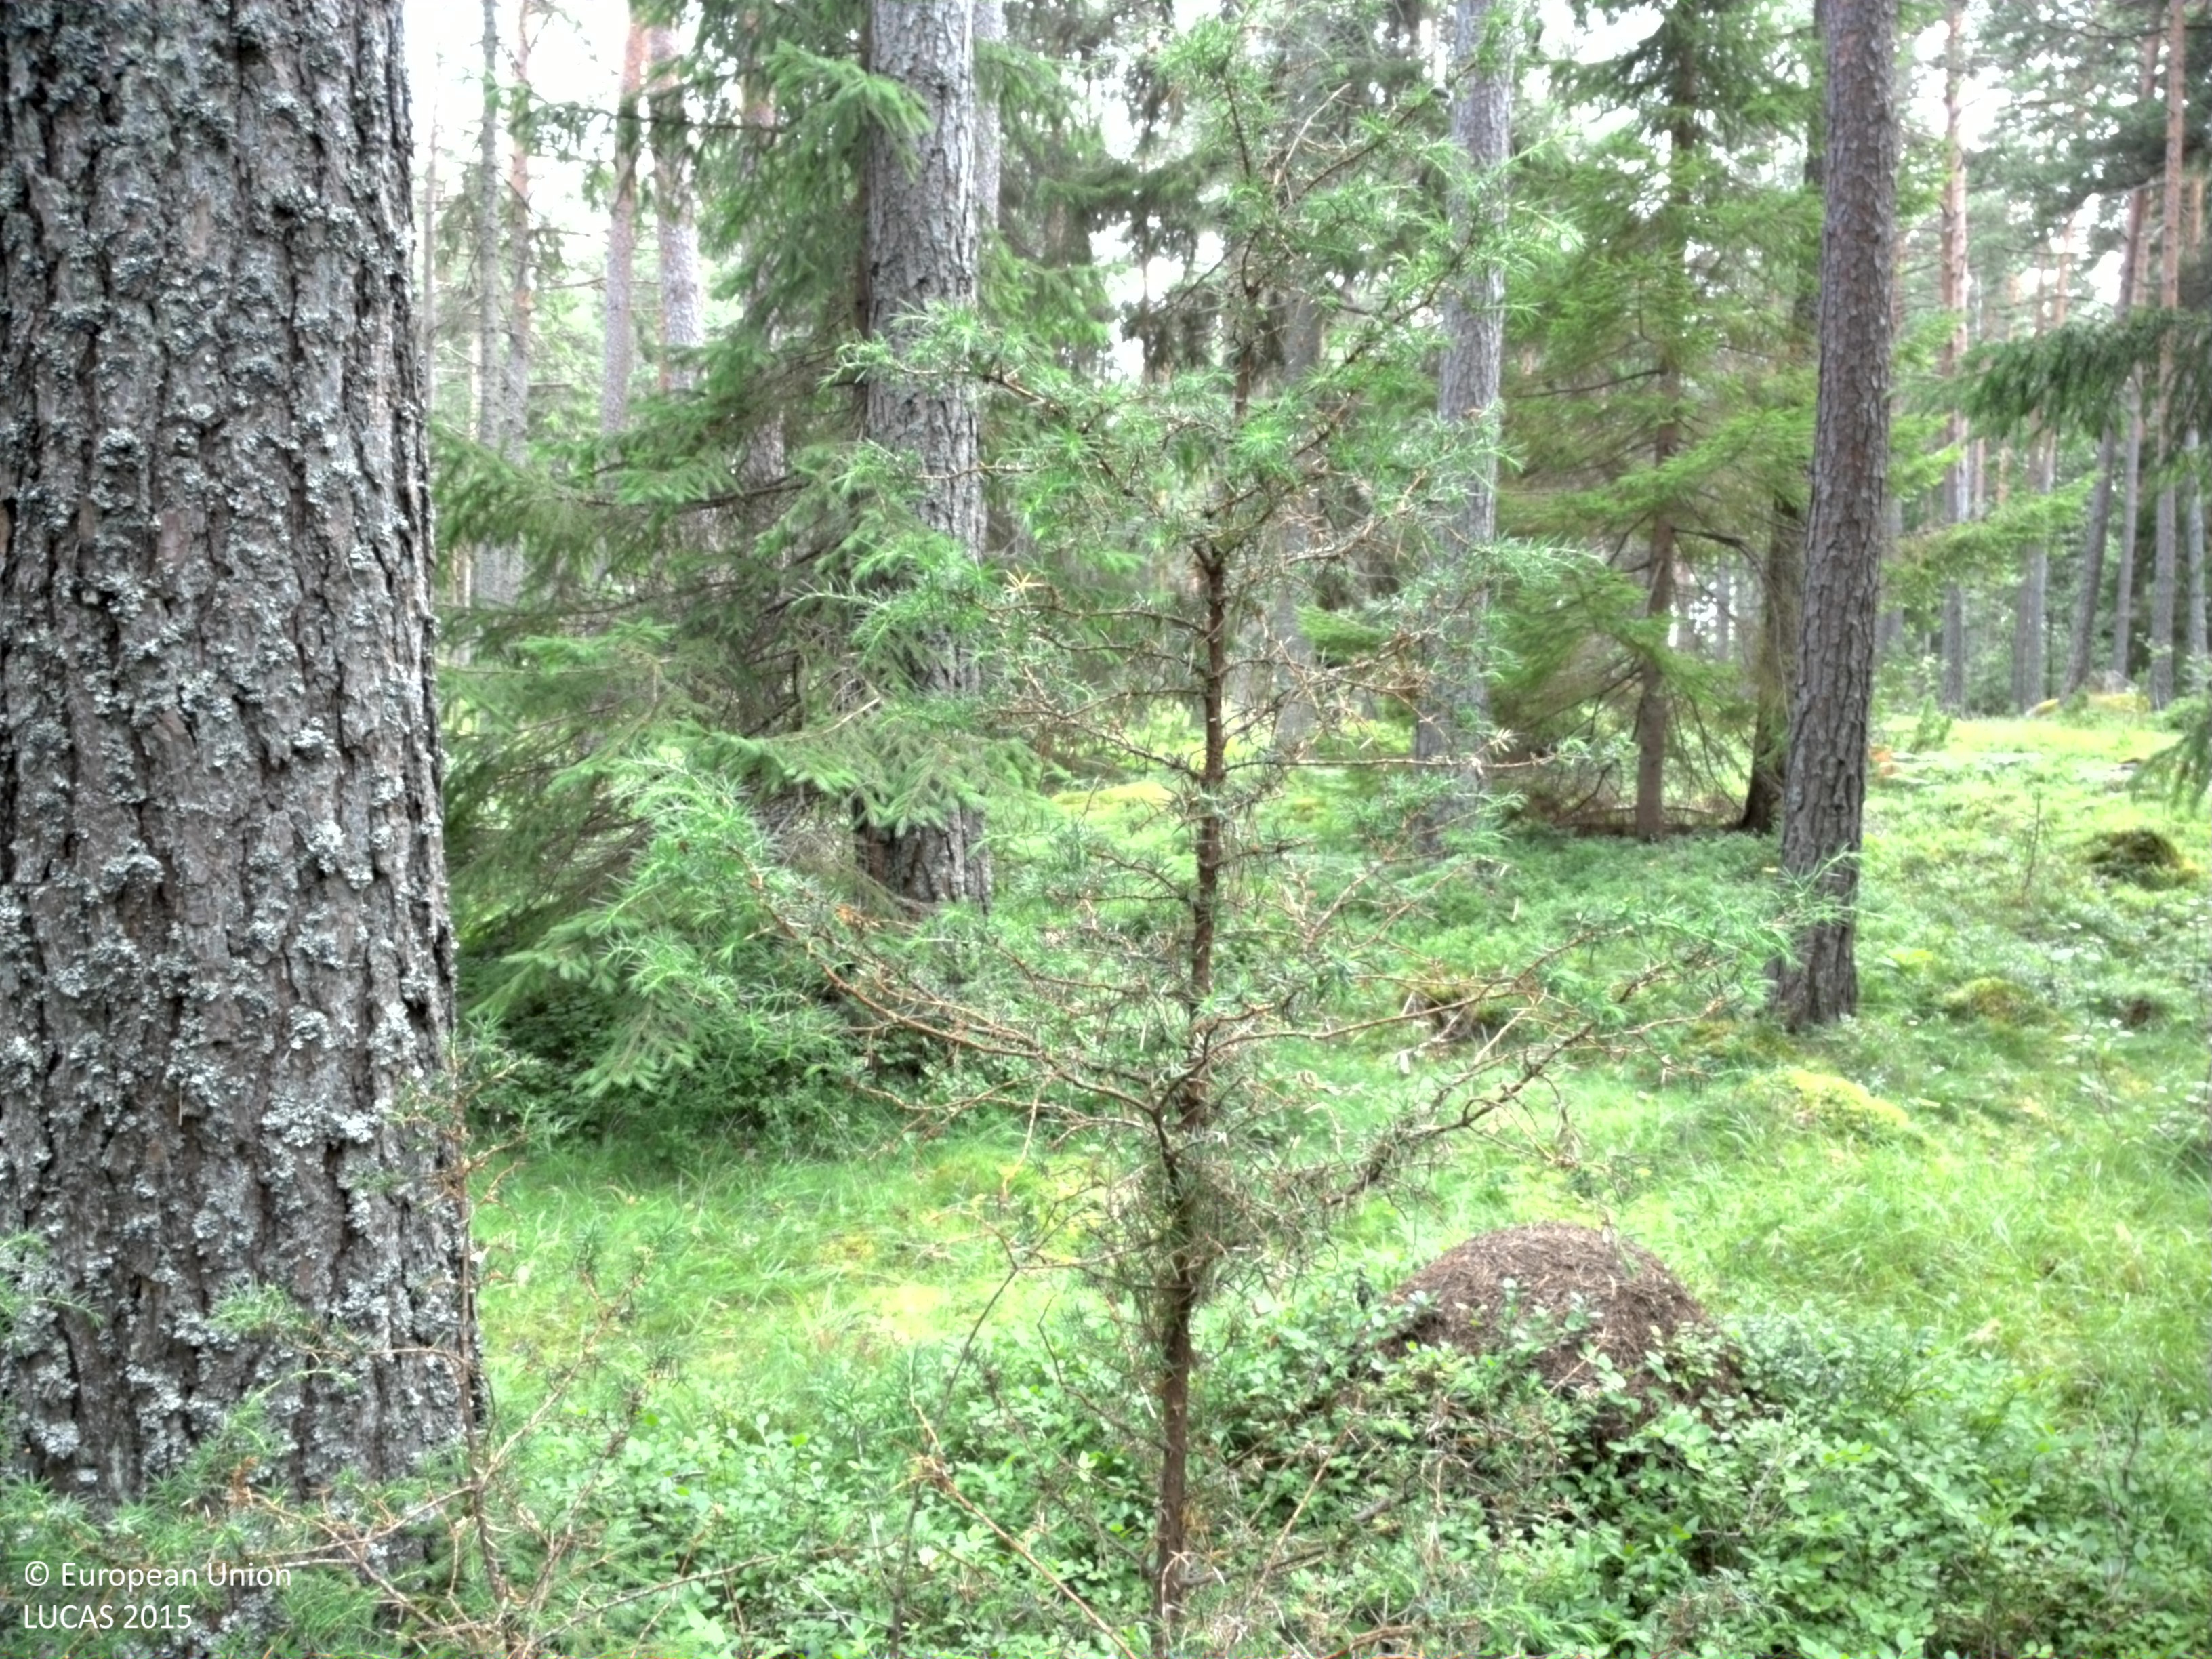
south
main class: Woodland
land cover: Spruce dominated coniferous woodland
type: boreal forest
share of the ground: 50 - 75 %
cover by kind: coniferous forest trees 70 %, shrubs 10 %, lichens and mosses 10 %, broadleaved forest trees 5 %, herbaceous plants 5 %
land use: Forestry
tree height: > 5 m
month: July
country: SE
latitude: 59.5187
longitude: 18.6079
